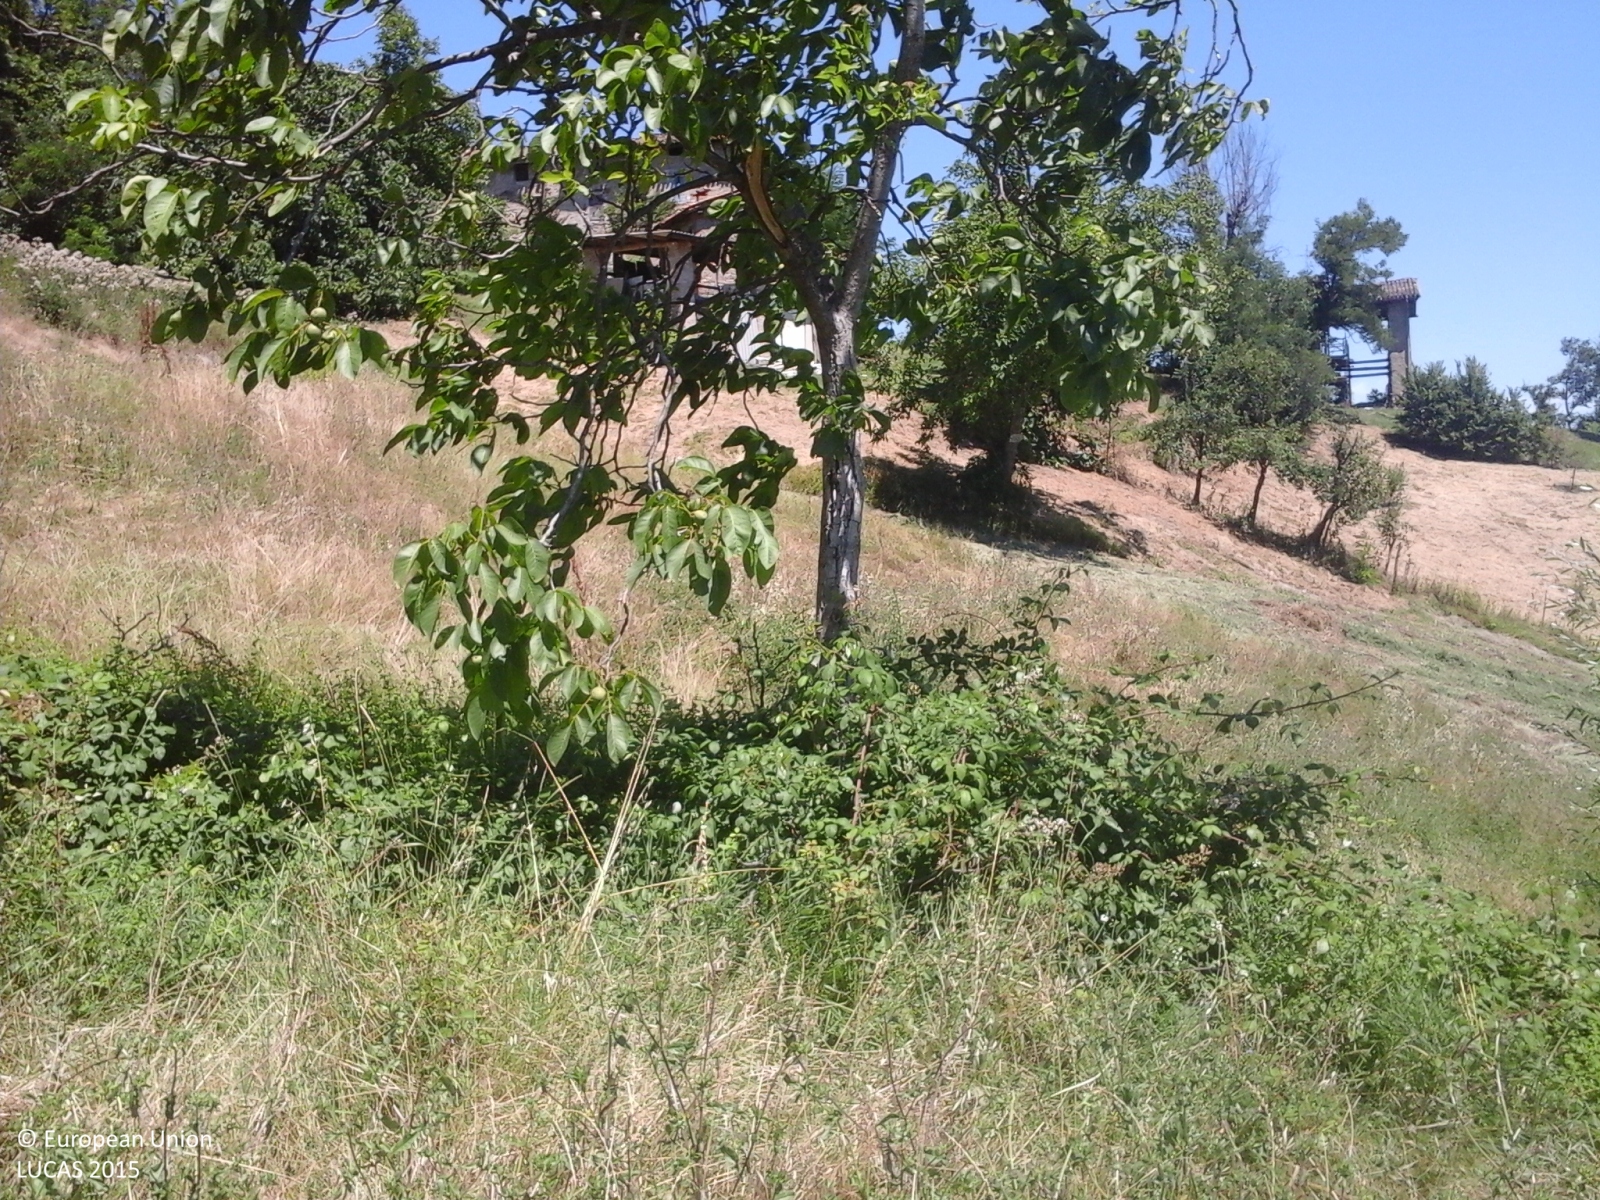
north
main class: Grassland
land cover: Grassland without tree/shrub cover
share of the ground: > 75 %
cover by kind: herbaceous plants 100 %
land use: Agriculture (excluding fallow land and kitchen gardens)
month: June
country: IT
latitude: 44.5288
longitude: 10.6654
